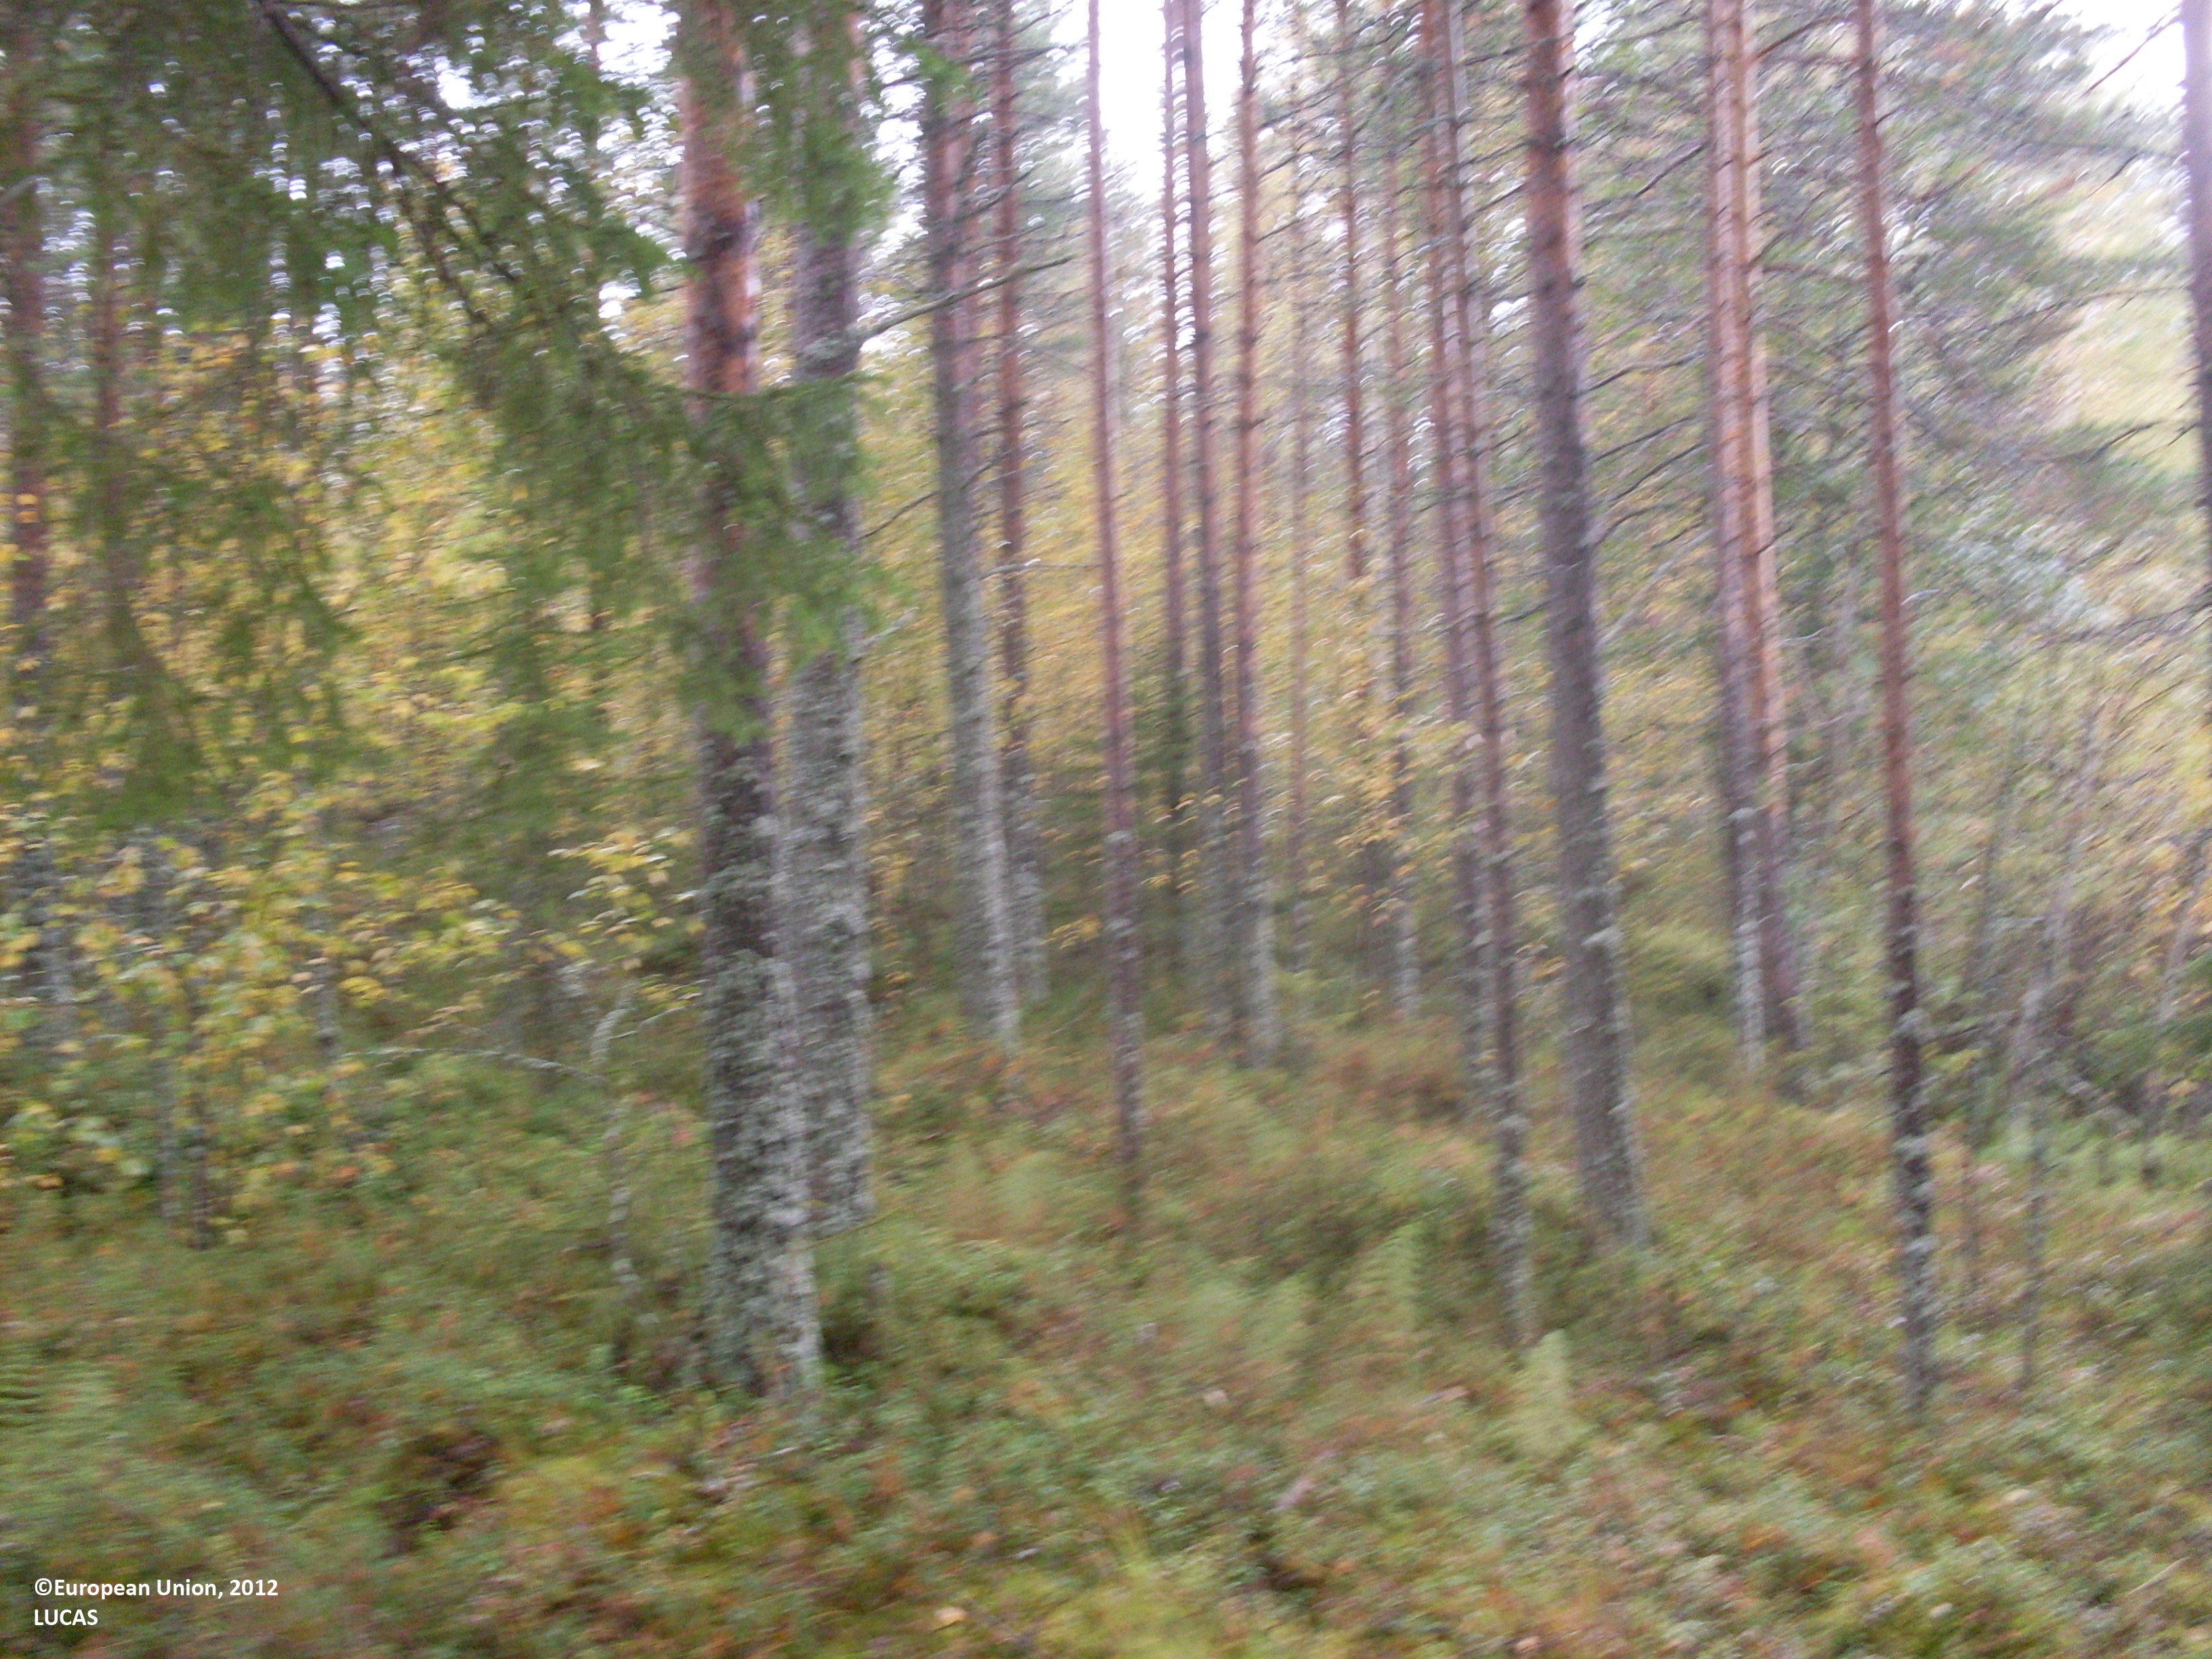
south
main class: Woodland
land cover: Pine dominated mixed woodland
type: boreal forest
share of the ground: > 75 %
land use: Forestry
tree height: > 5 m
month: September
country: FI
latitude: 64.0150
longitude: 30.1946
